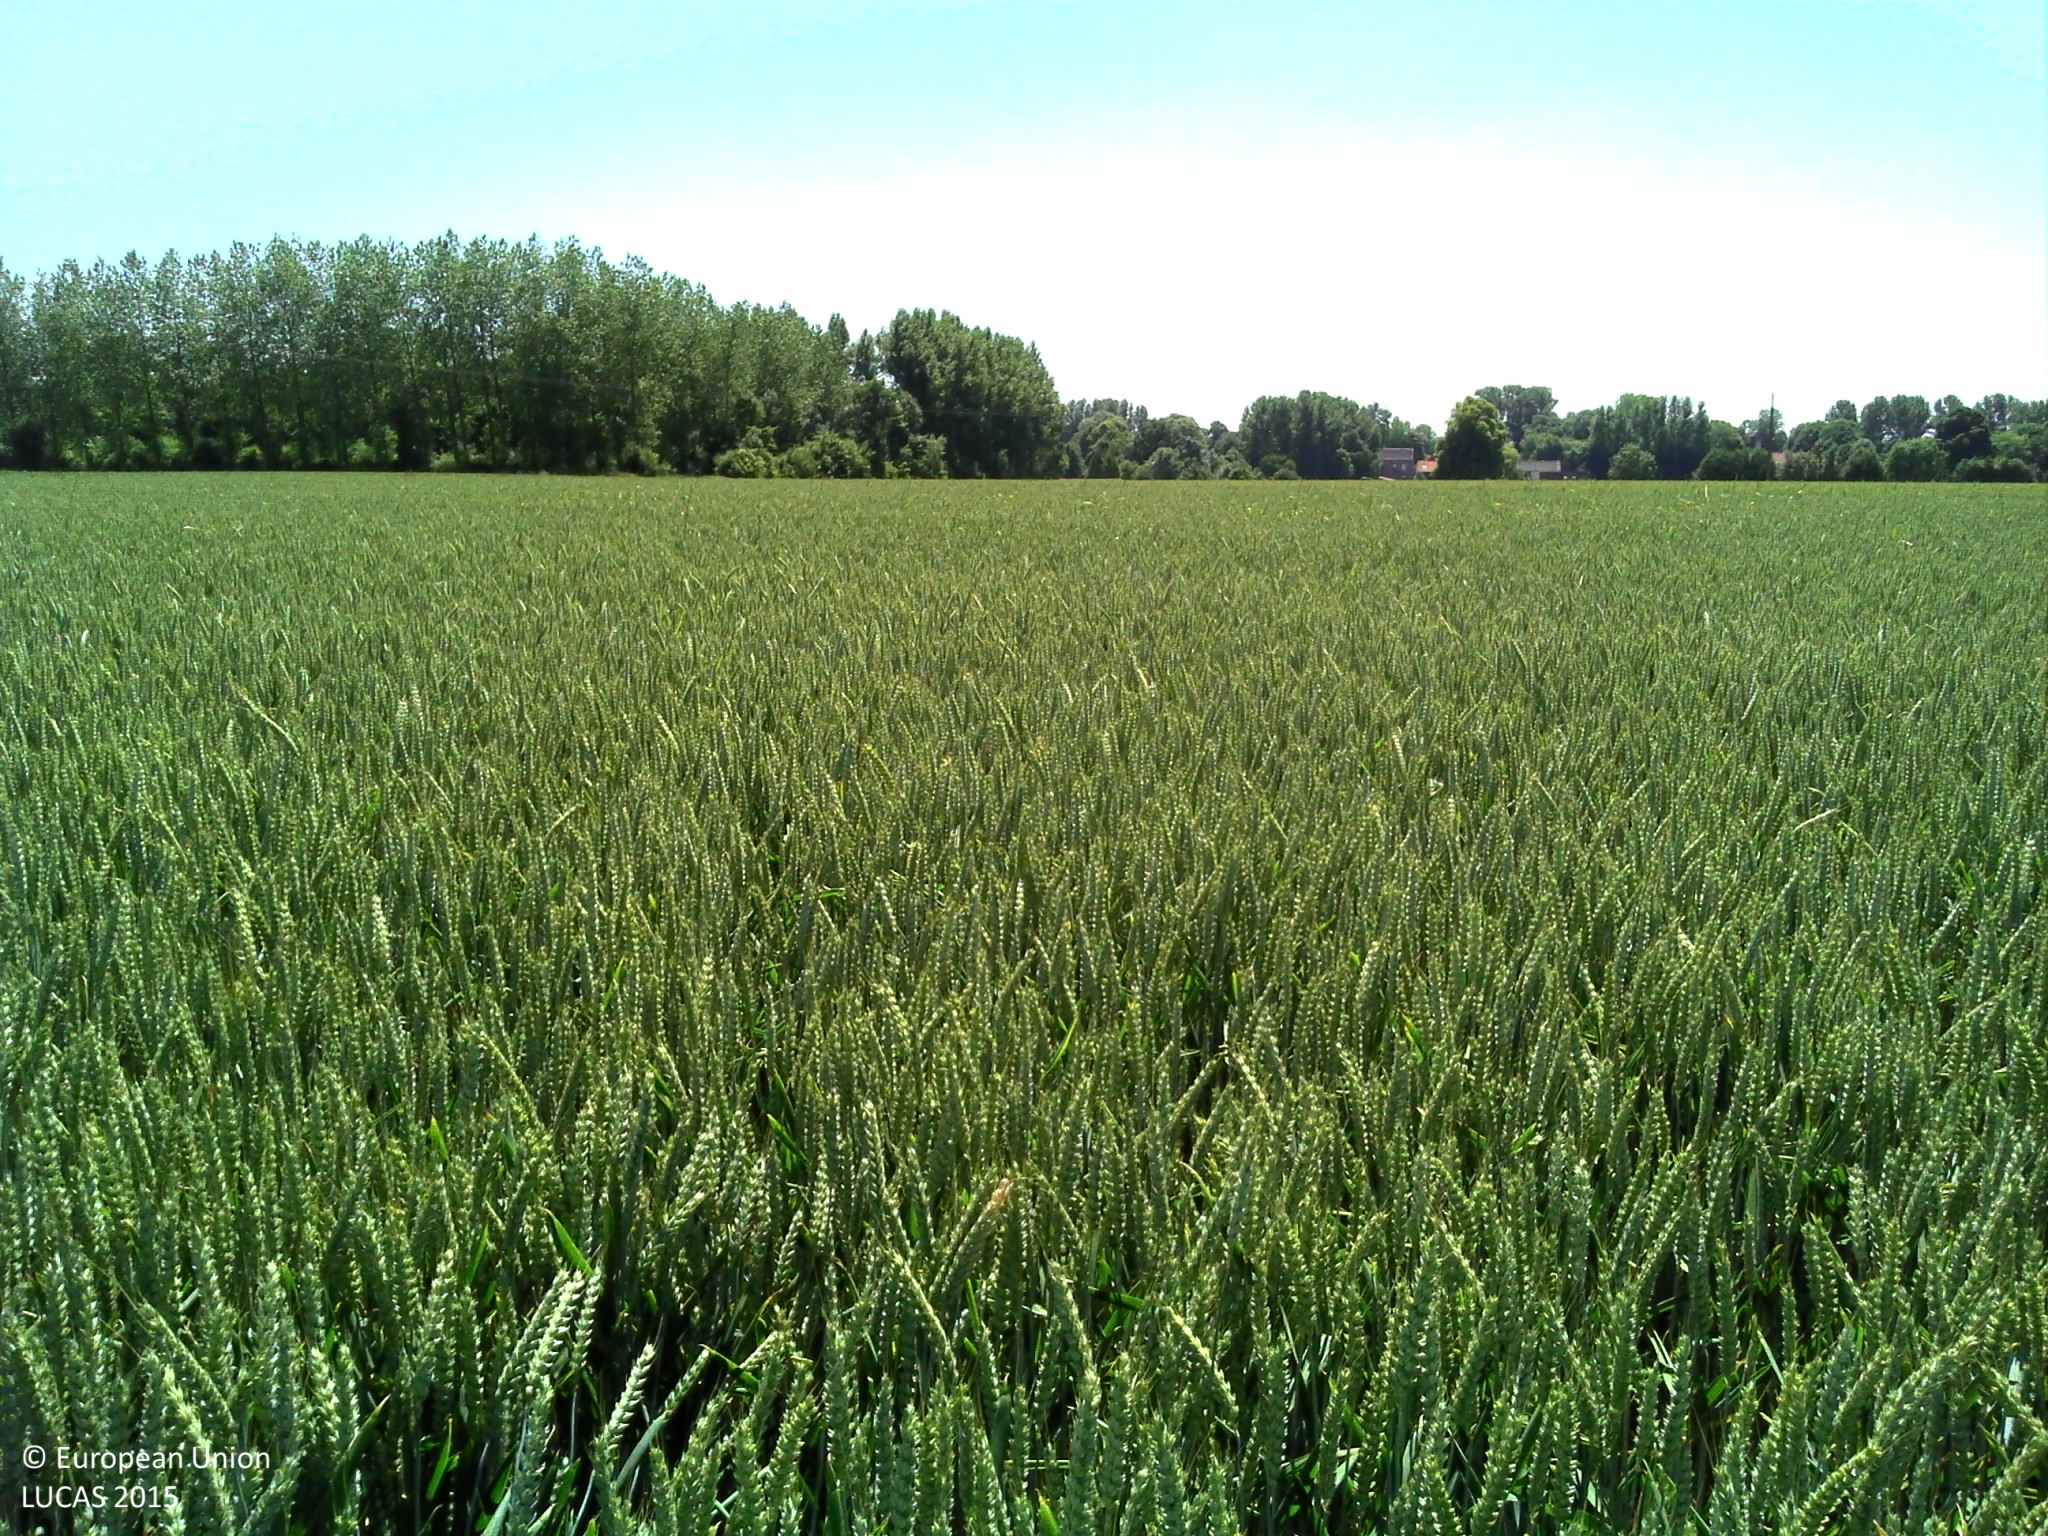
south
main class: Cropland
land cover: Common wheat
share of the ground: > 75 %
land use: Agriculture (excluding fallow land and kitchen gardens)
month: June
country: FR
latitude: 50.3269
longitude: 2.3874
